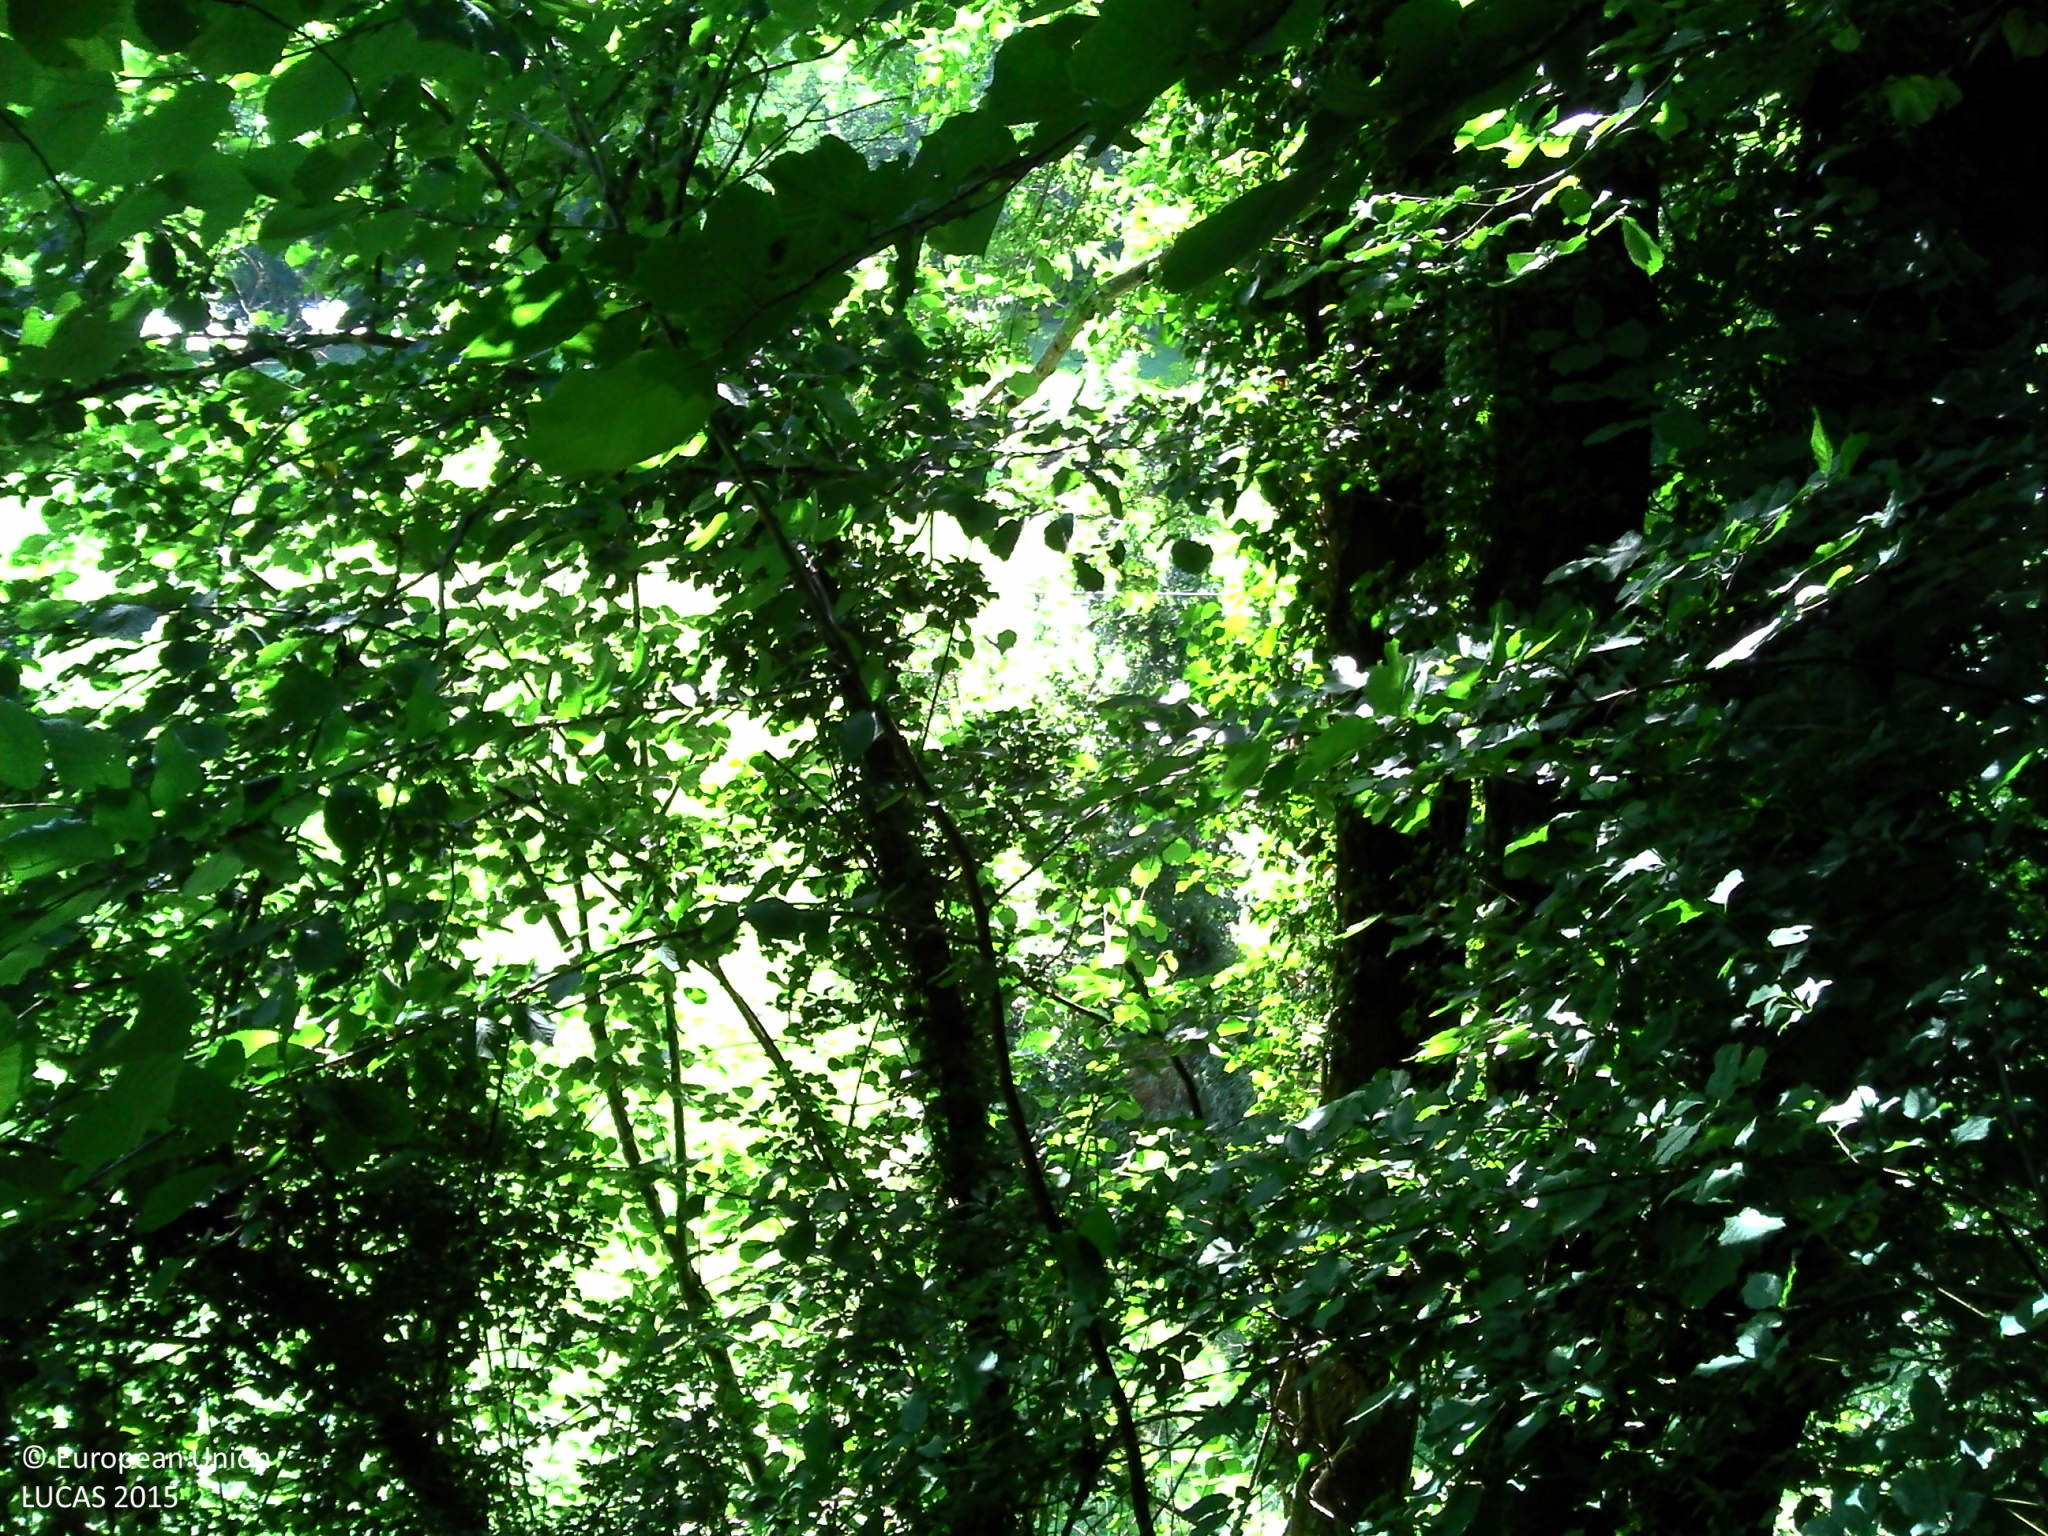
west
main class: Woodland
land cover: Broadleaved woodland
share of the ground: > 75 %
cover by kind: broadleaved forest trees 55 %, herbaceous plants 35 %, shrubs 10 %
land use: Agriculture (excluding fallow land and kitchen gardens)
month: July
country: FR
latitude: 42.9885
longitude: -0.4174
